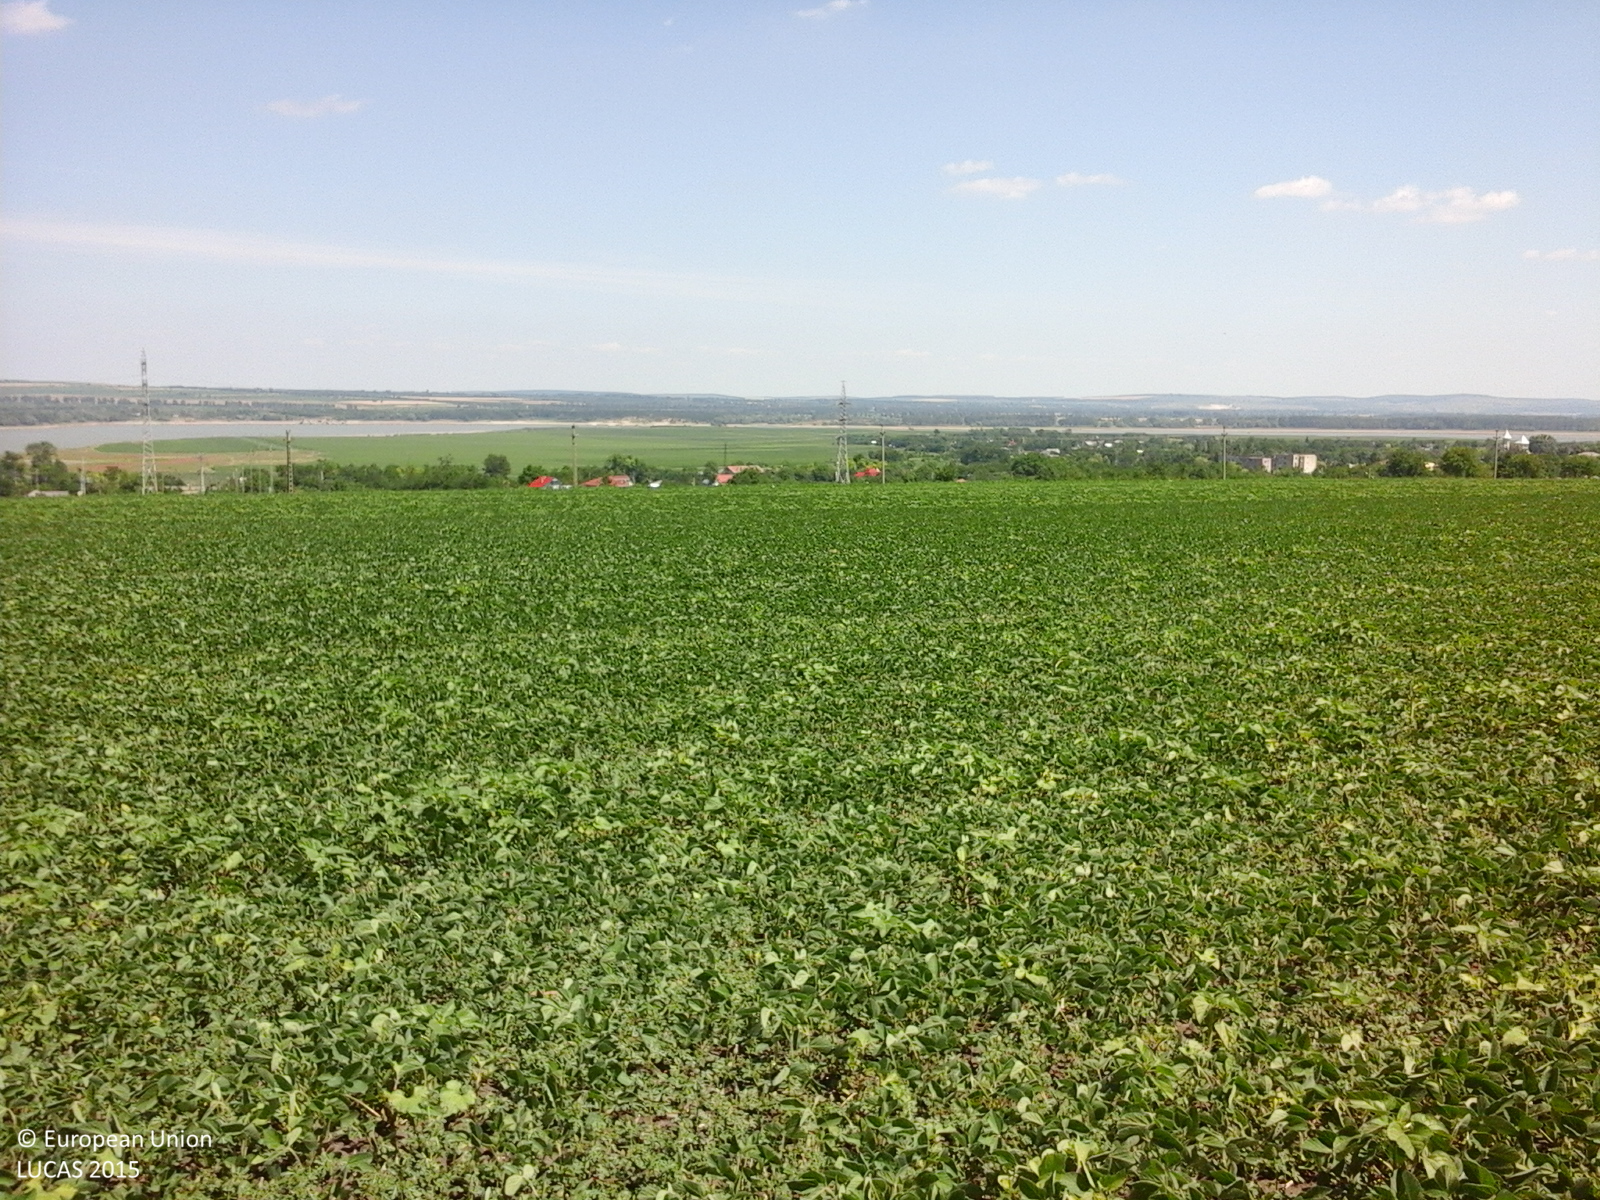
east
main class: Cropland
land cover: Soya
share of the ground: > 75 %
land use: Agriculture (excluding fallow land and kitchen gardens)
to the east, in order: Soya; Maize; Soya; Maize
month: June
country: RO
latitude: 47.9545
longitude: 27.1298
